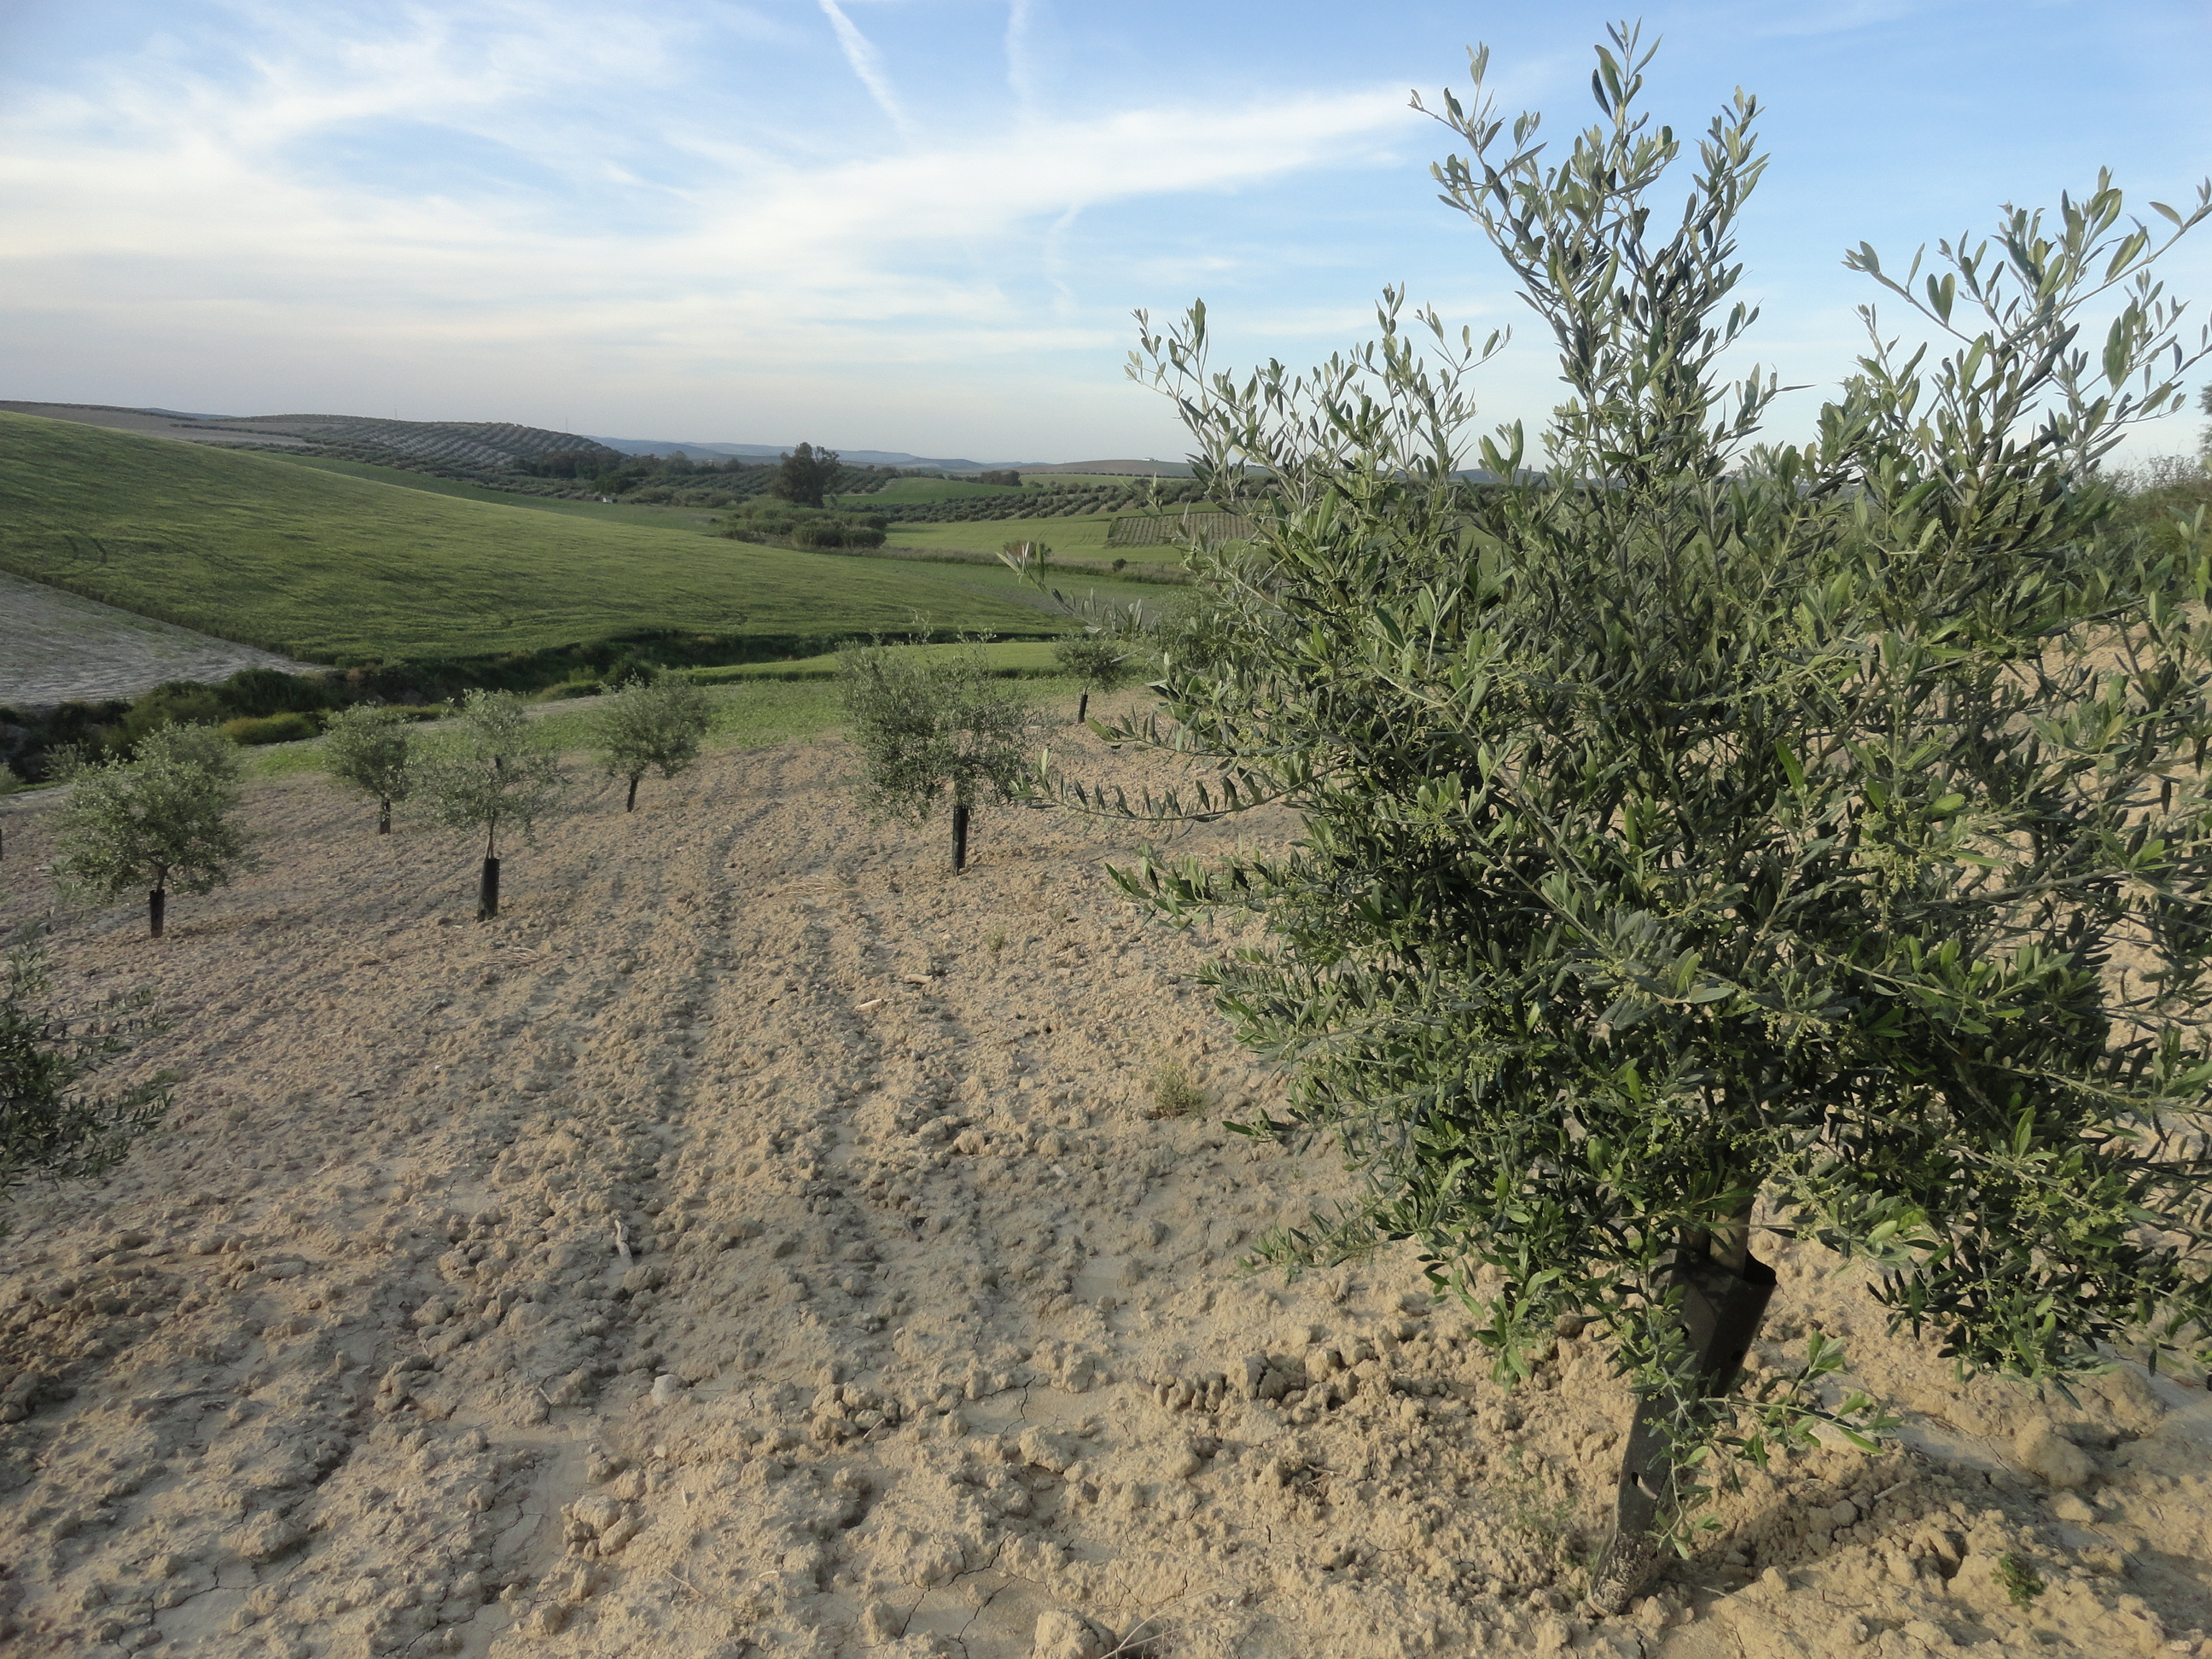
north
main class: Cropland
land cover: Olive groves
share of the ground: 10 - 25 %
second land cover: Other bare soil
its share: > 75 %
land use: Agriculture (excluding fallow land and kitchen gardens)
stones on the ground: < 10 %
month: April
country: ES
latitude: 37.6237
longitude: -4.6125
